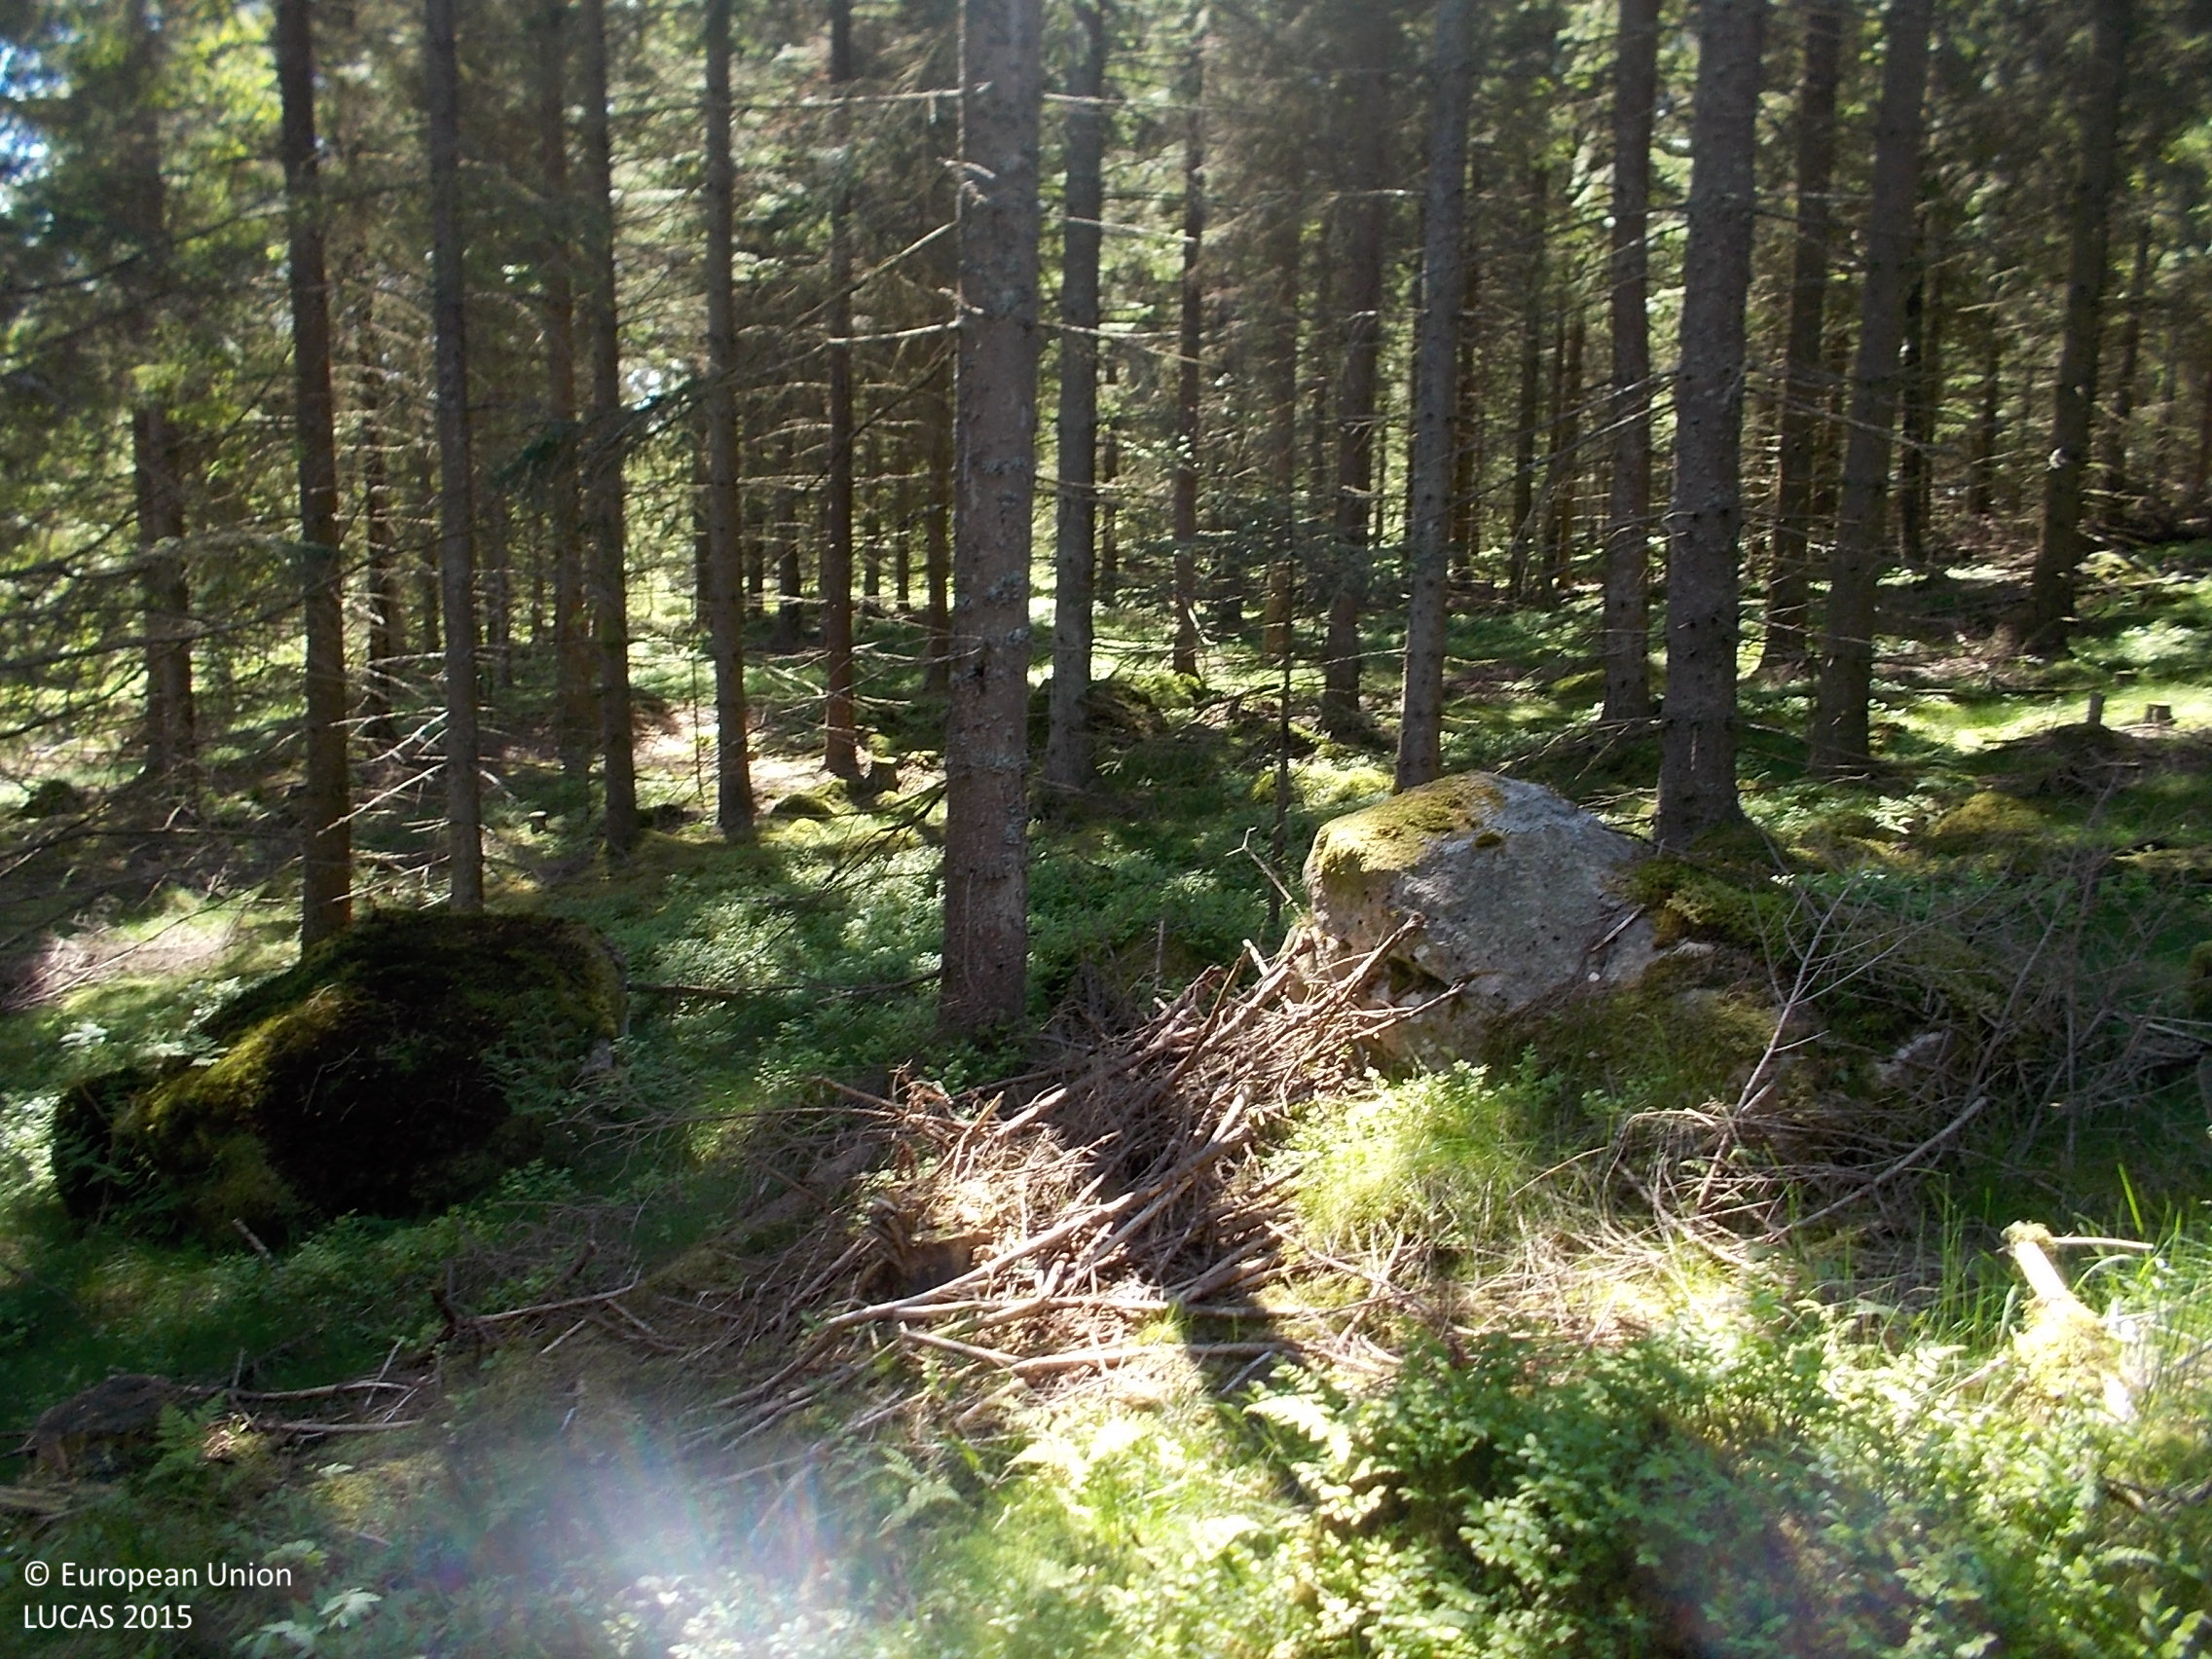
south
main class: Woodland
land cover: Spruce dominated coniferous woodland
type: boreal forest
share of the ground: > 75 %
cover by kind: coniferous forest trees 90 %, shrubs 5 %, lichens and mosses 5 %
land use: Forestry
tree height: > 5 m
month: June
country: SE
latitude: 57.7314
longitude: 13.2029
